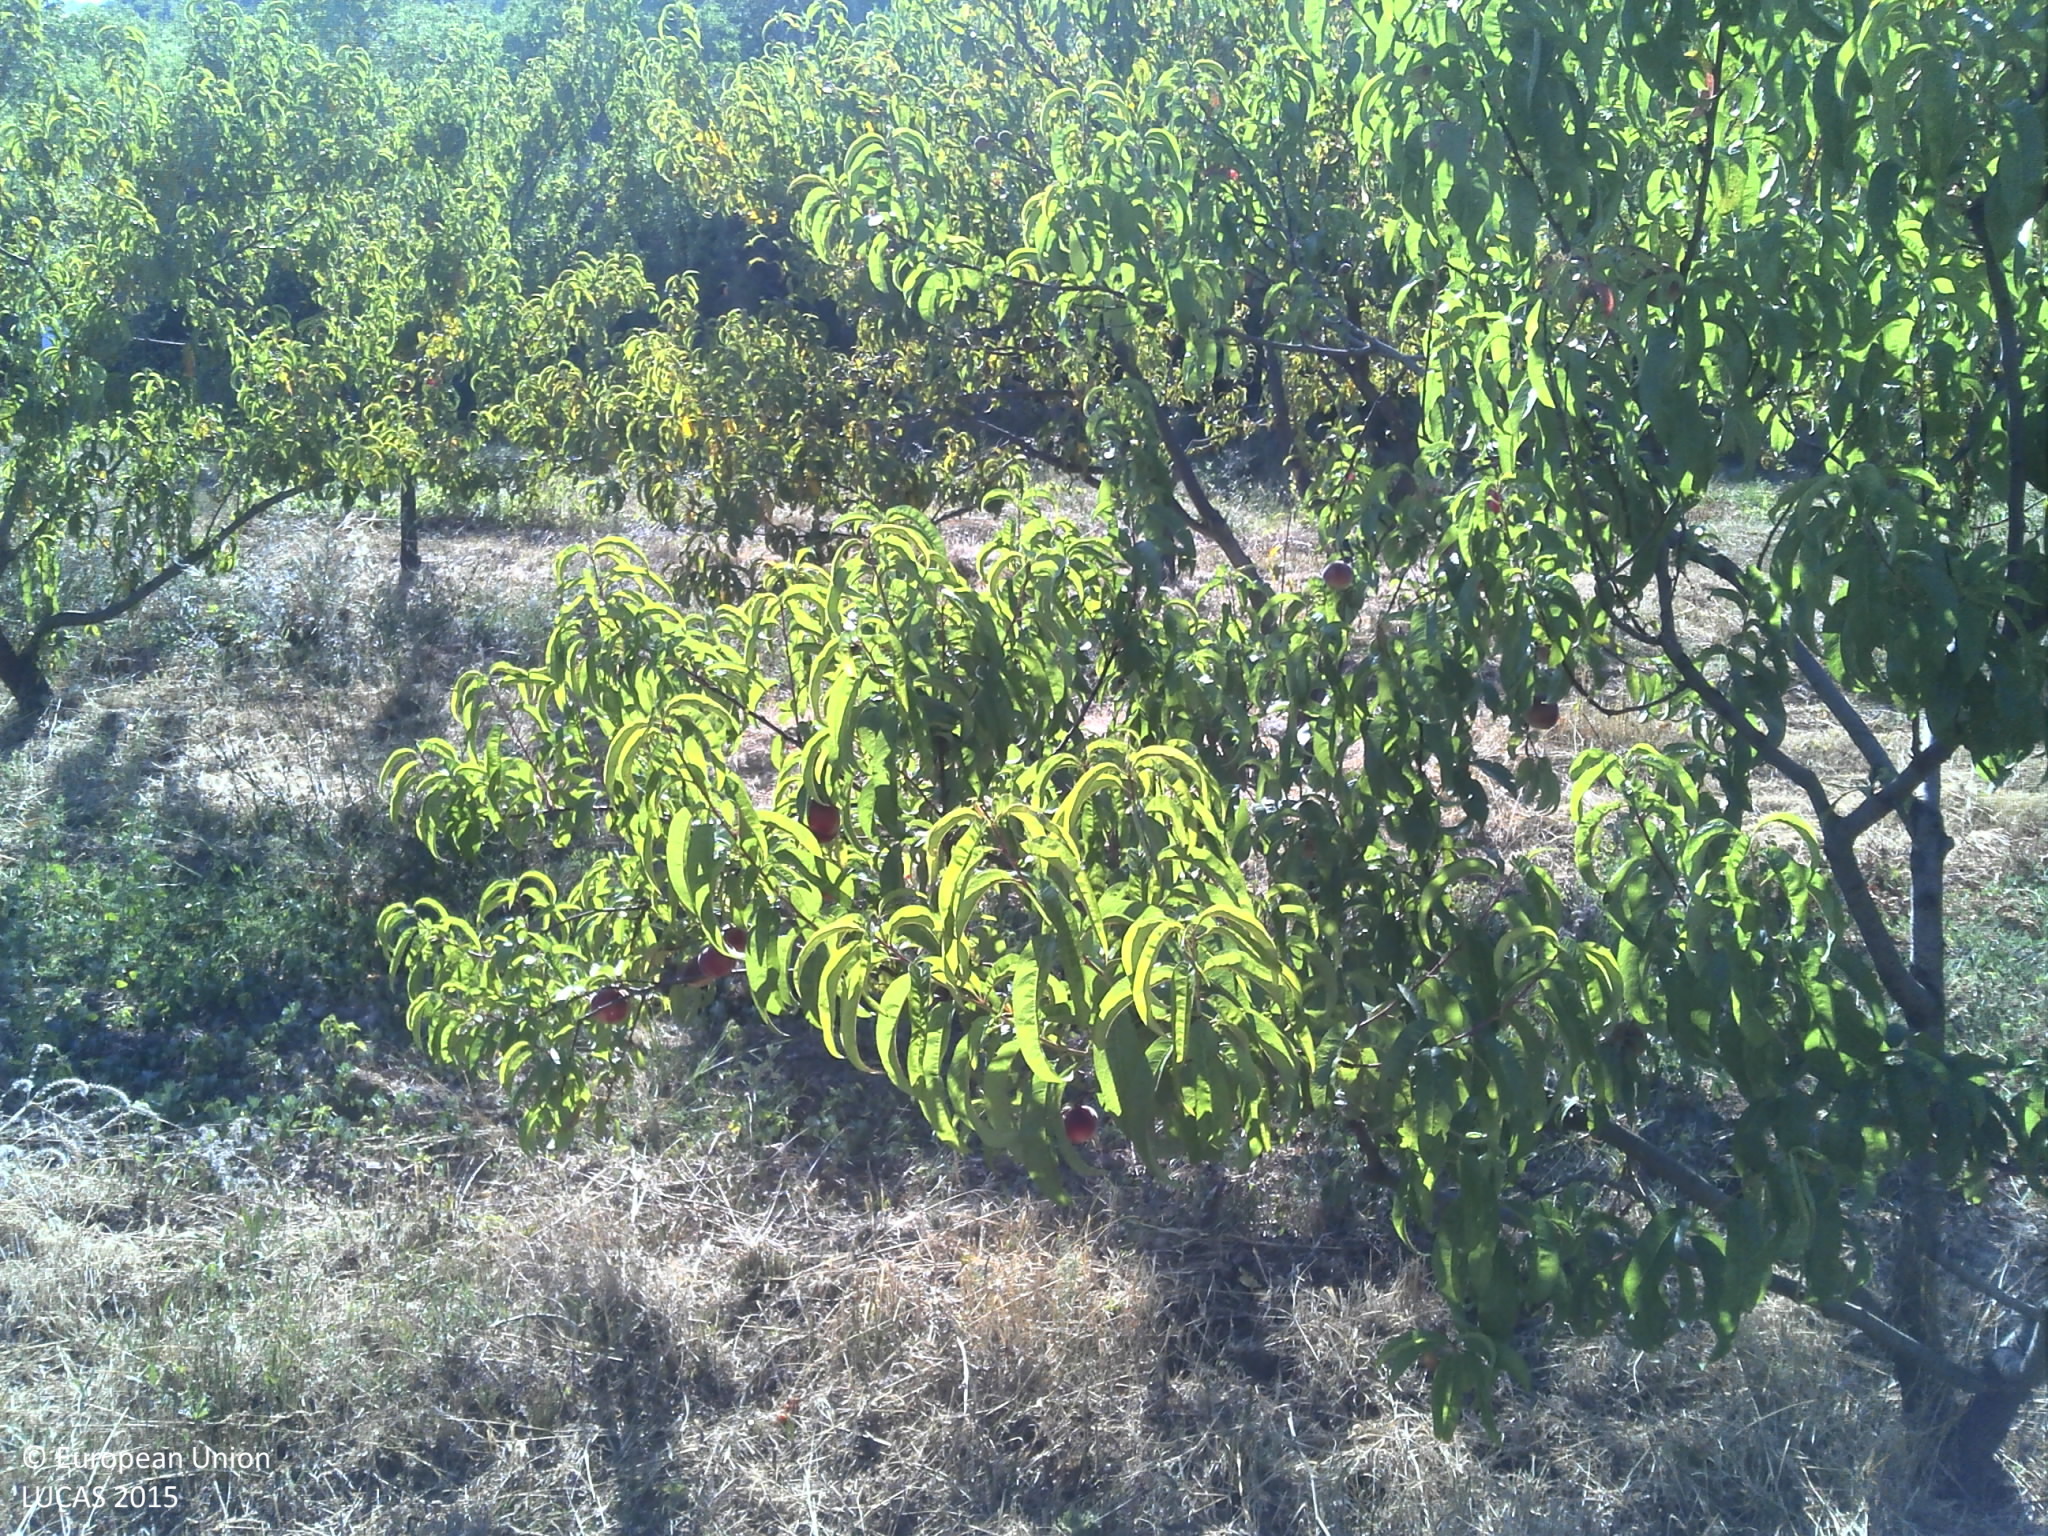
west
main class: Cropland
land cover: Other fruit trees and berries
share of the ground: 10 - 25 %
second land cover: Spontaneously vegetated surfaces
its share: > 75 %
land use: Agriculture (excluding fallow land and kitchen gardens)
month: July
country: FR
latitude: 43.6519
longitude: 3.1267
